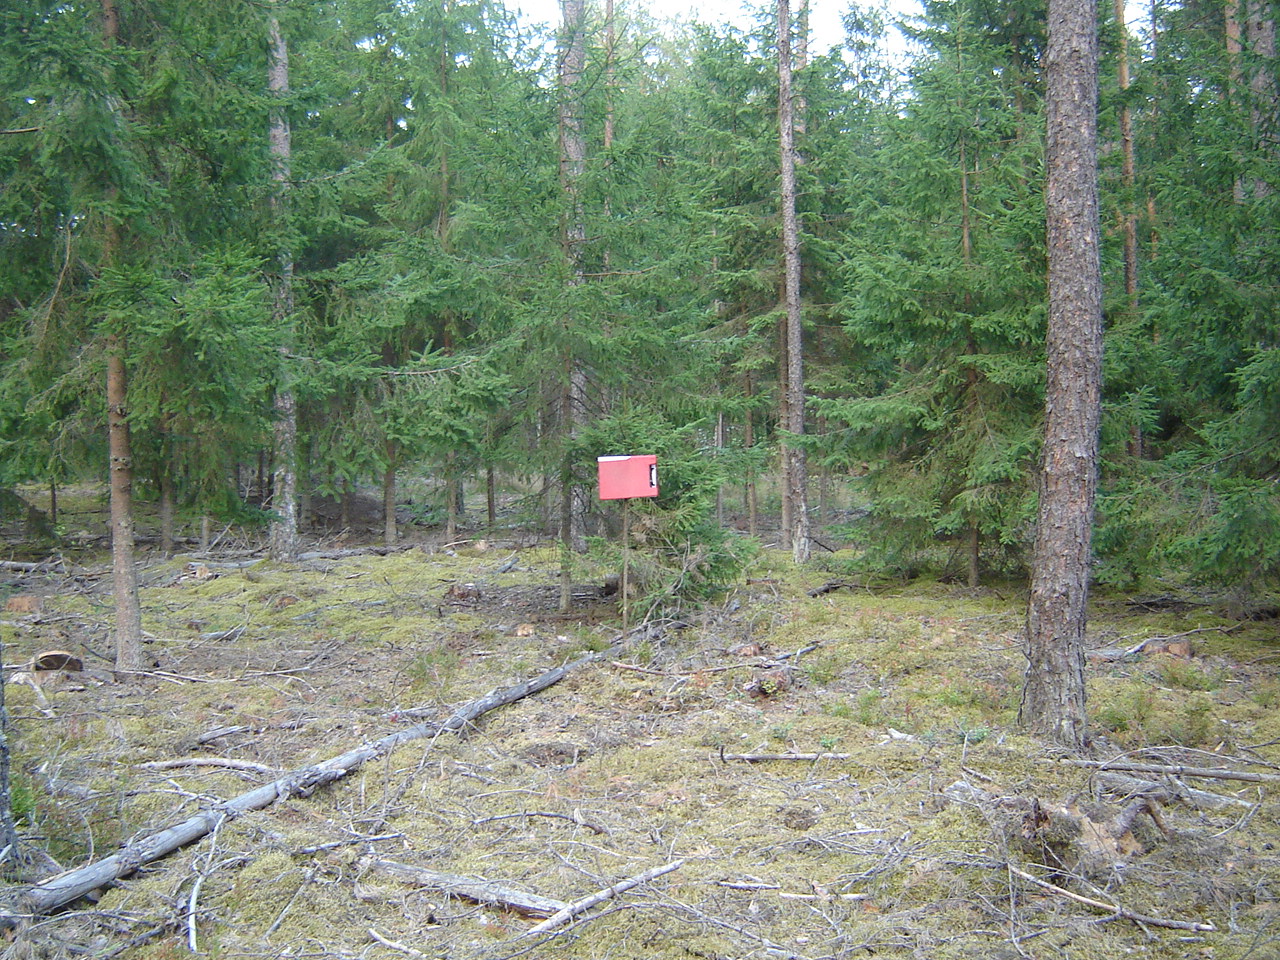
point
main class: Woodland
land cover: Pine dominated coniferous woodland
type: hemiboreal forest and nemoral coniferous forest and mixed broadleaved-coniferous forest
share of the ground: 50 - 75 %
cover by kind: coniferous forest trees 60 %, lichens and mosses 35 %, broadleaved forest trees 5 %
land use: Forestry
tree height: > 5 m
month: September
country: LT
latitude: 54.4080
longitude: 24.7927
